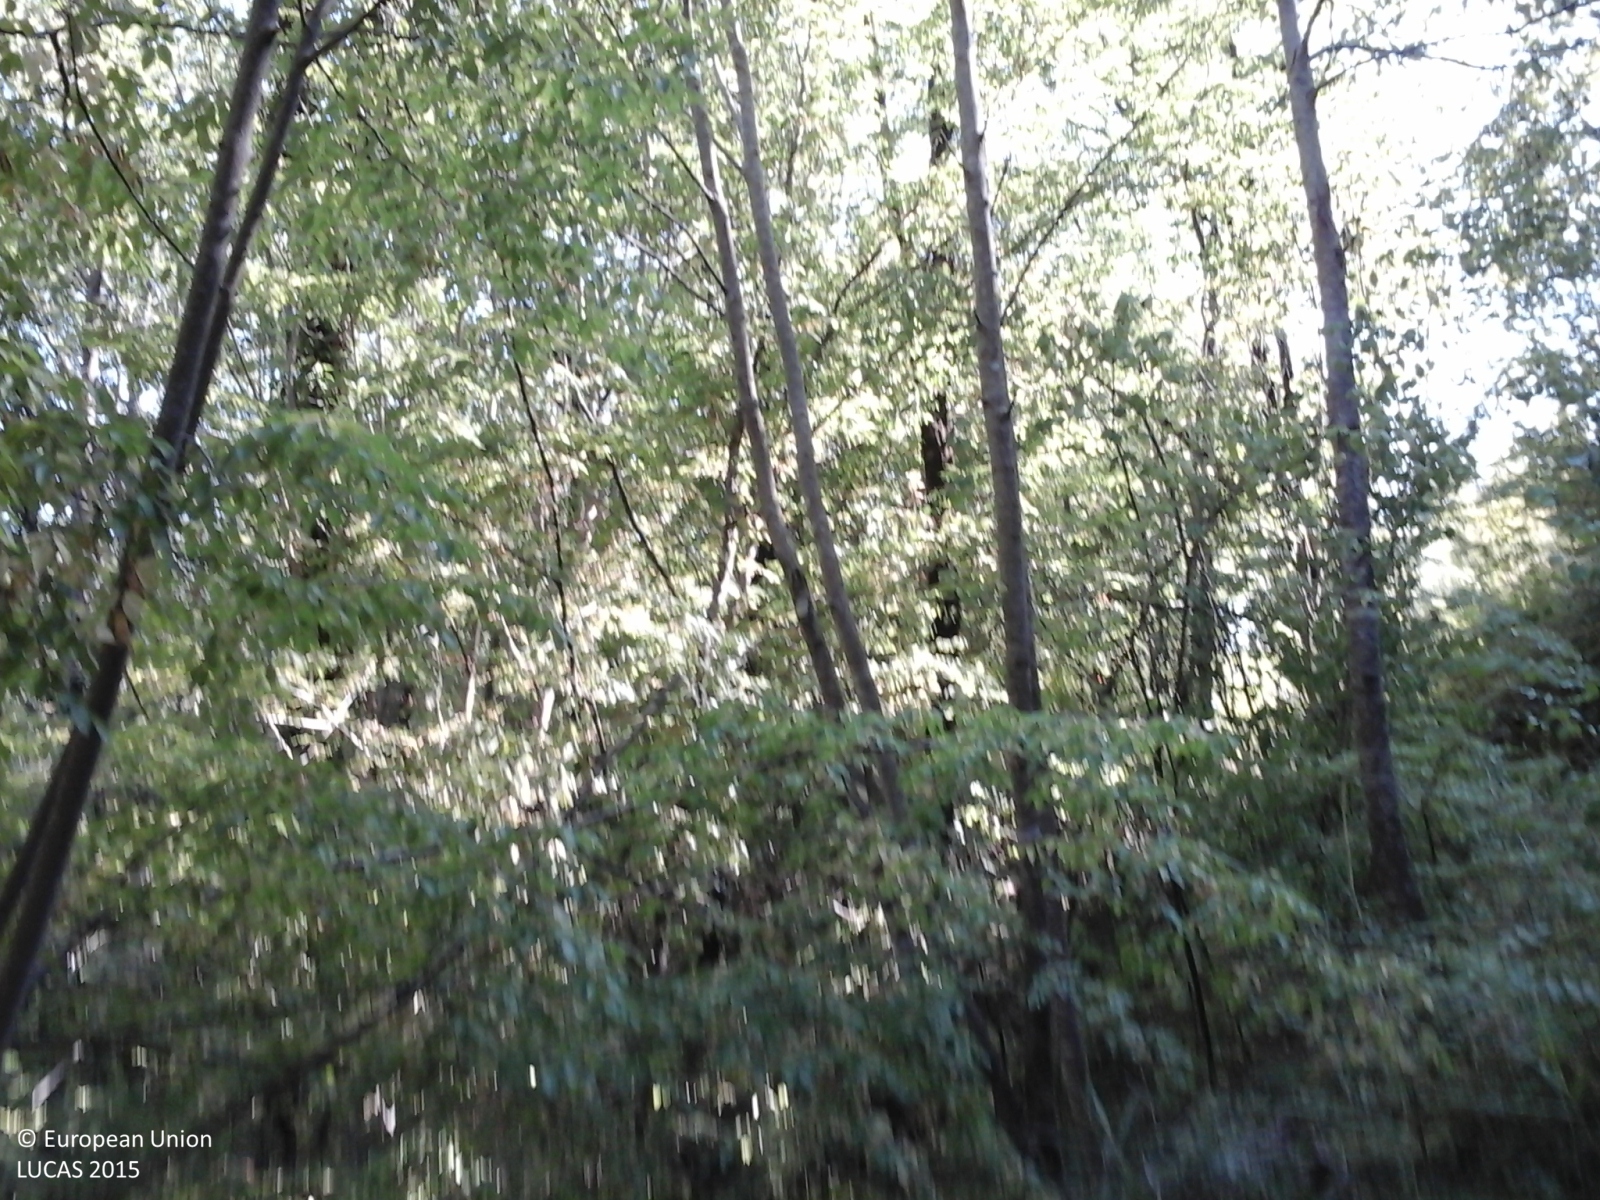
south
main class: Woodland
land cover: Broadleaved woodland
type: thermophilous deciduous forest
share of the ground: > 75 %
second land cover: Grassland without tree/shrub cover
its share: > 75 %
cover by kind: broadleaved forest trees 85 %, shrubs 10 %, herbaceous plants 5 %
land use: Forestry
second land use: Agriculture (excluding fallow land and kitchen gardens)
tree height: > 5 m
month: September
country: IT
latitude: 41.6454
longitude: 14.1753
